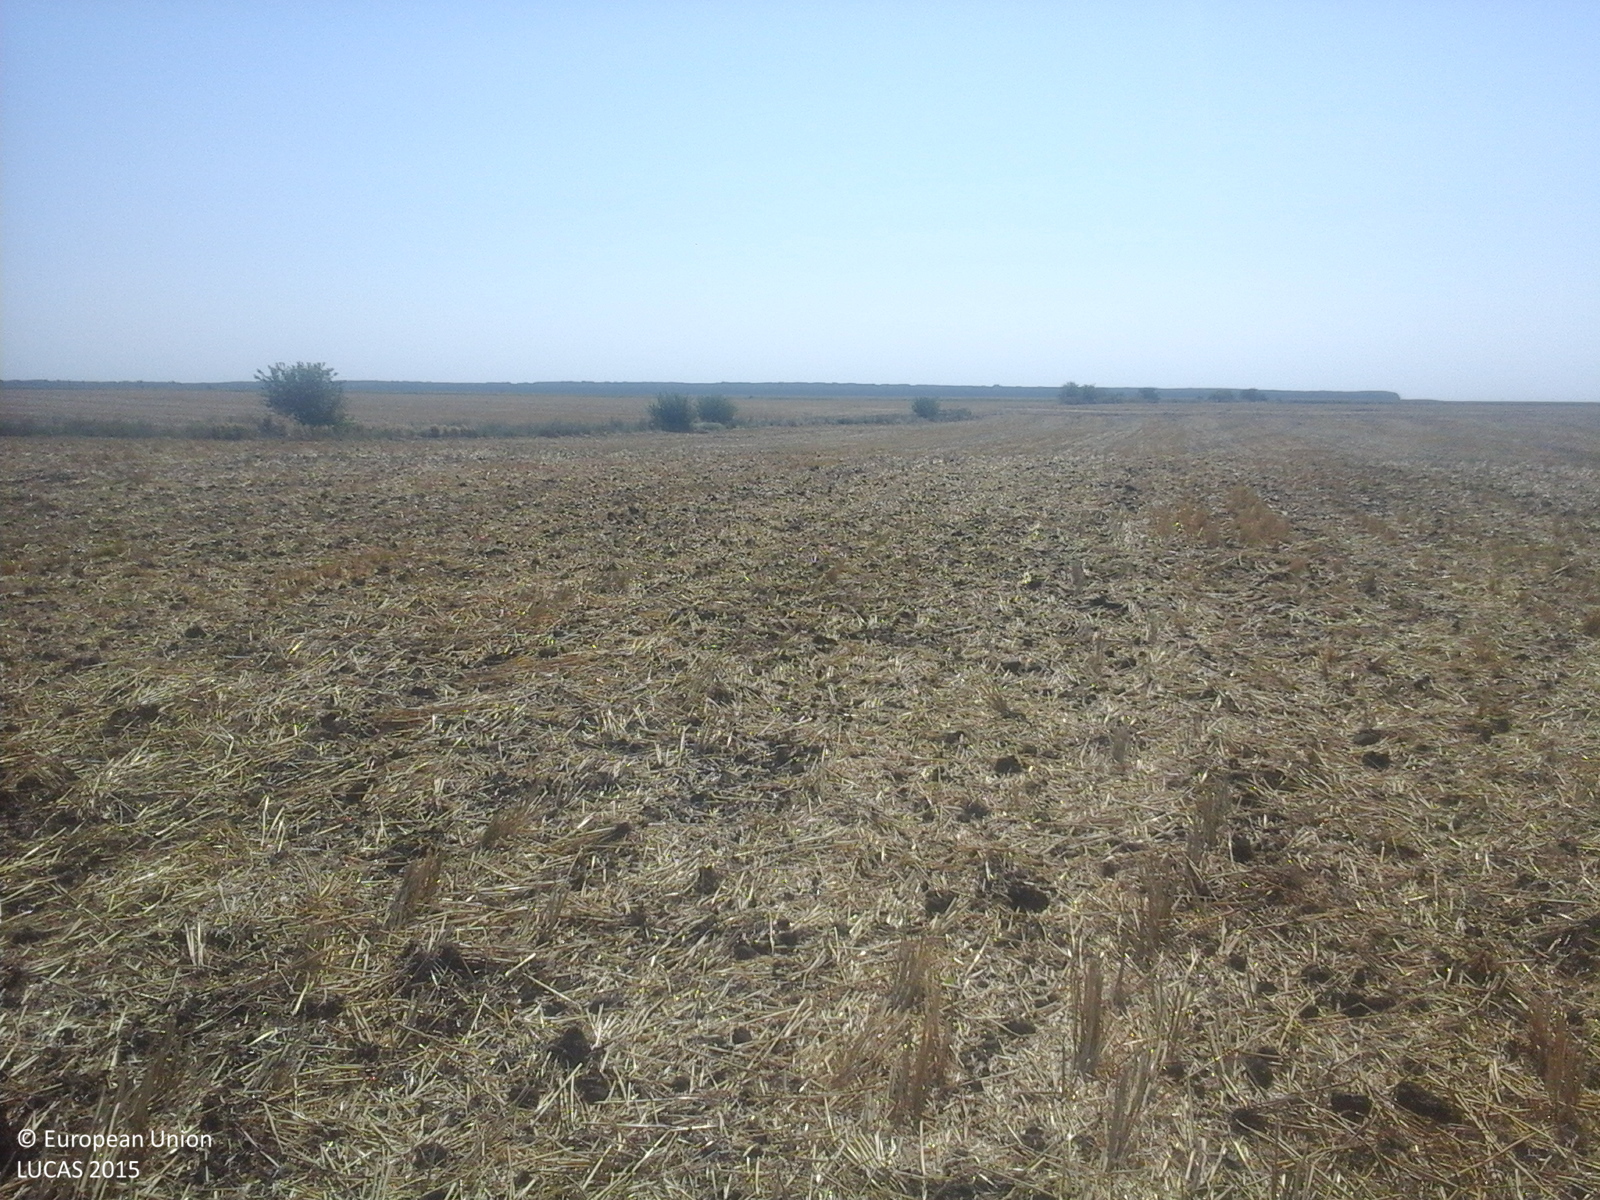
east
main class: Cropland
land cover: Common wheat
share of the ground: 10 - 25 %
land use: Agriculture (excluding fallow land and kitchen gardens)
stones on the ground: < 10 %
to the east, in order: Common wheat; Electric lines; Durum wheat; Grass margins; Ditches and canals; Grass margins; Durum wheat
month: July
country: RO
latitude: 44.3665
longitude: 27.1341
